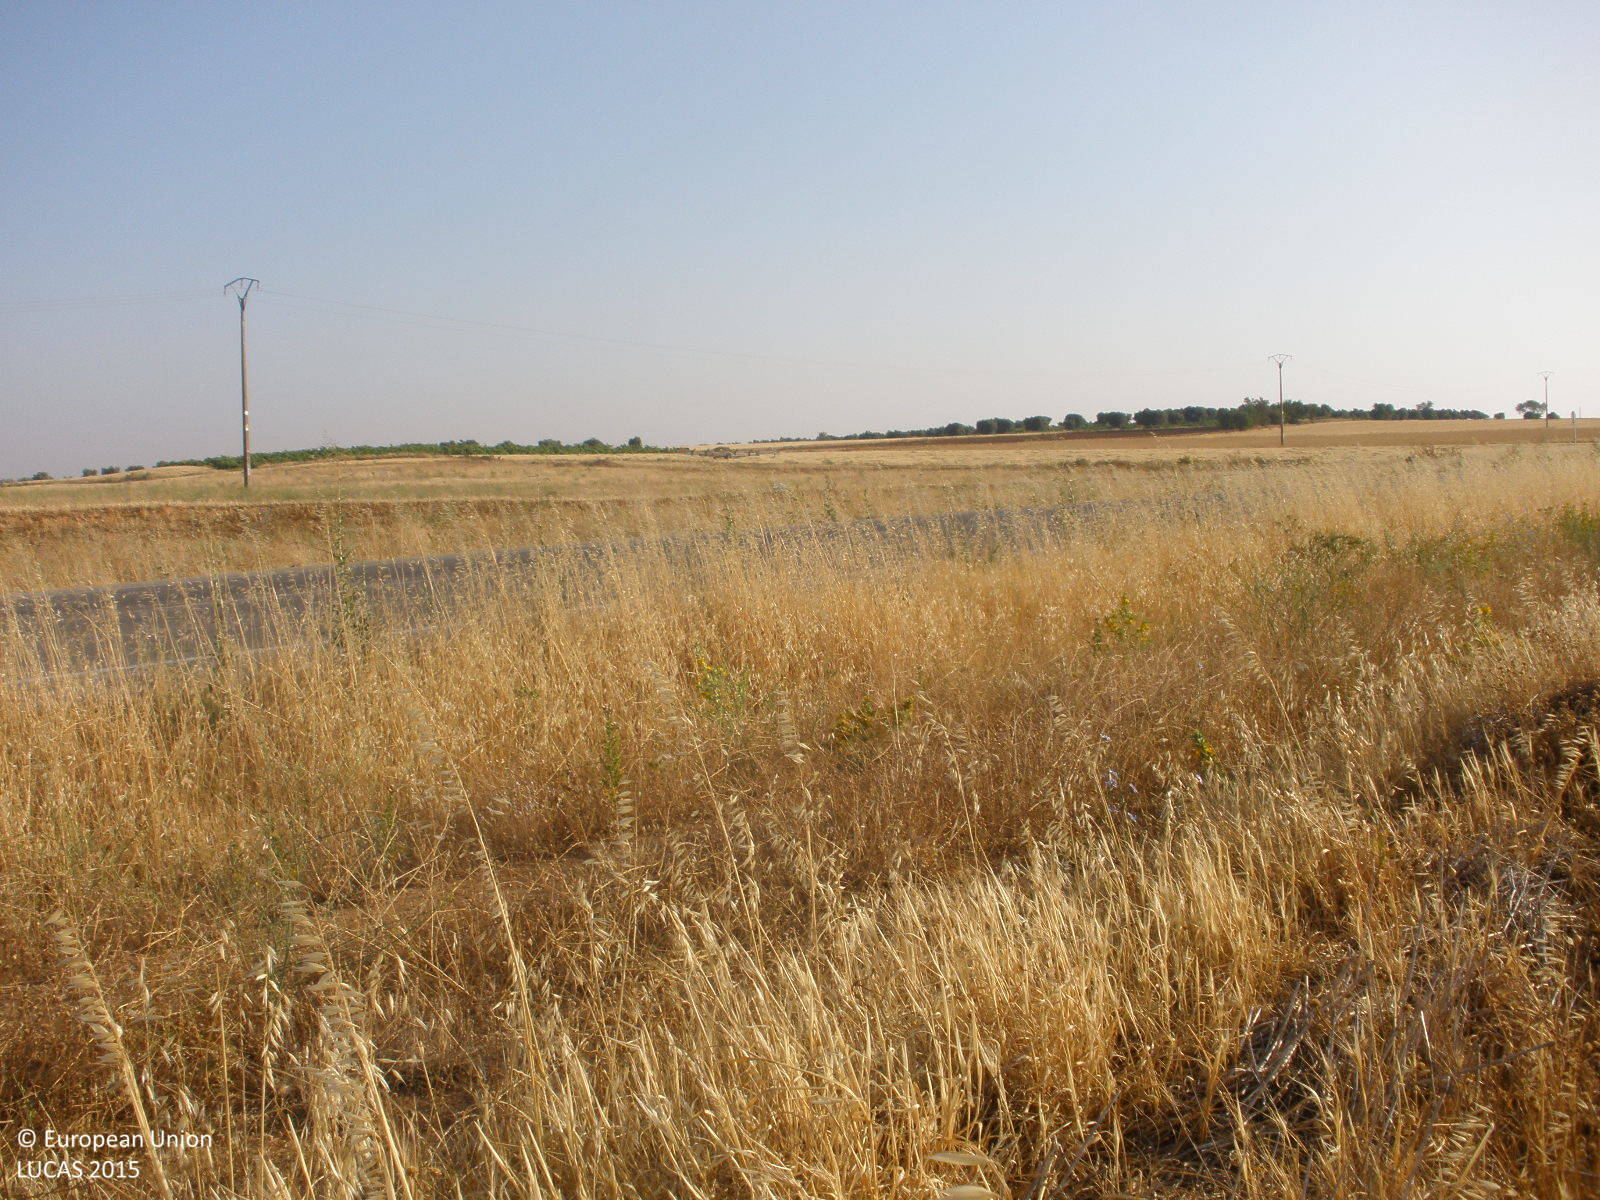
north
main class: Cropland
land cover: Oats
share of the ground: < 10 %
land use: Agriculture (excluding fallow land and kitchen gardens)
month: July
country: ES
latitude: 39.8037
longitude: -3.1155
